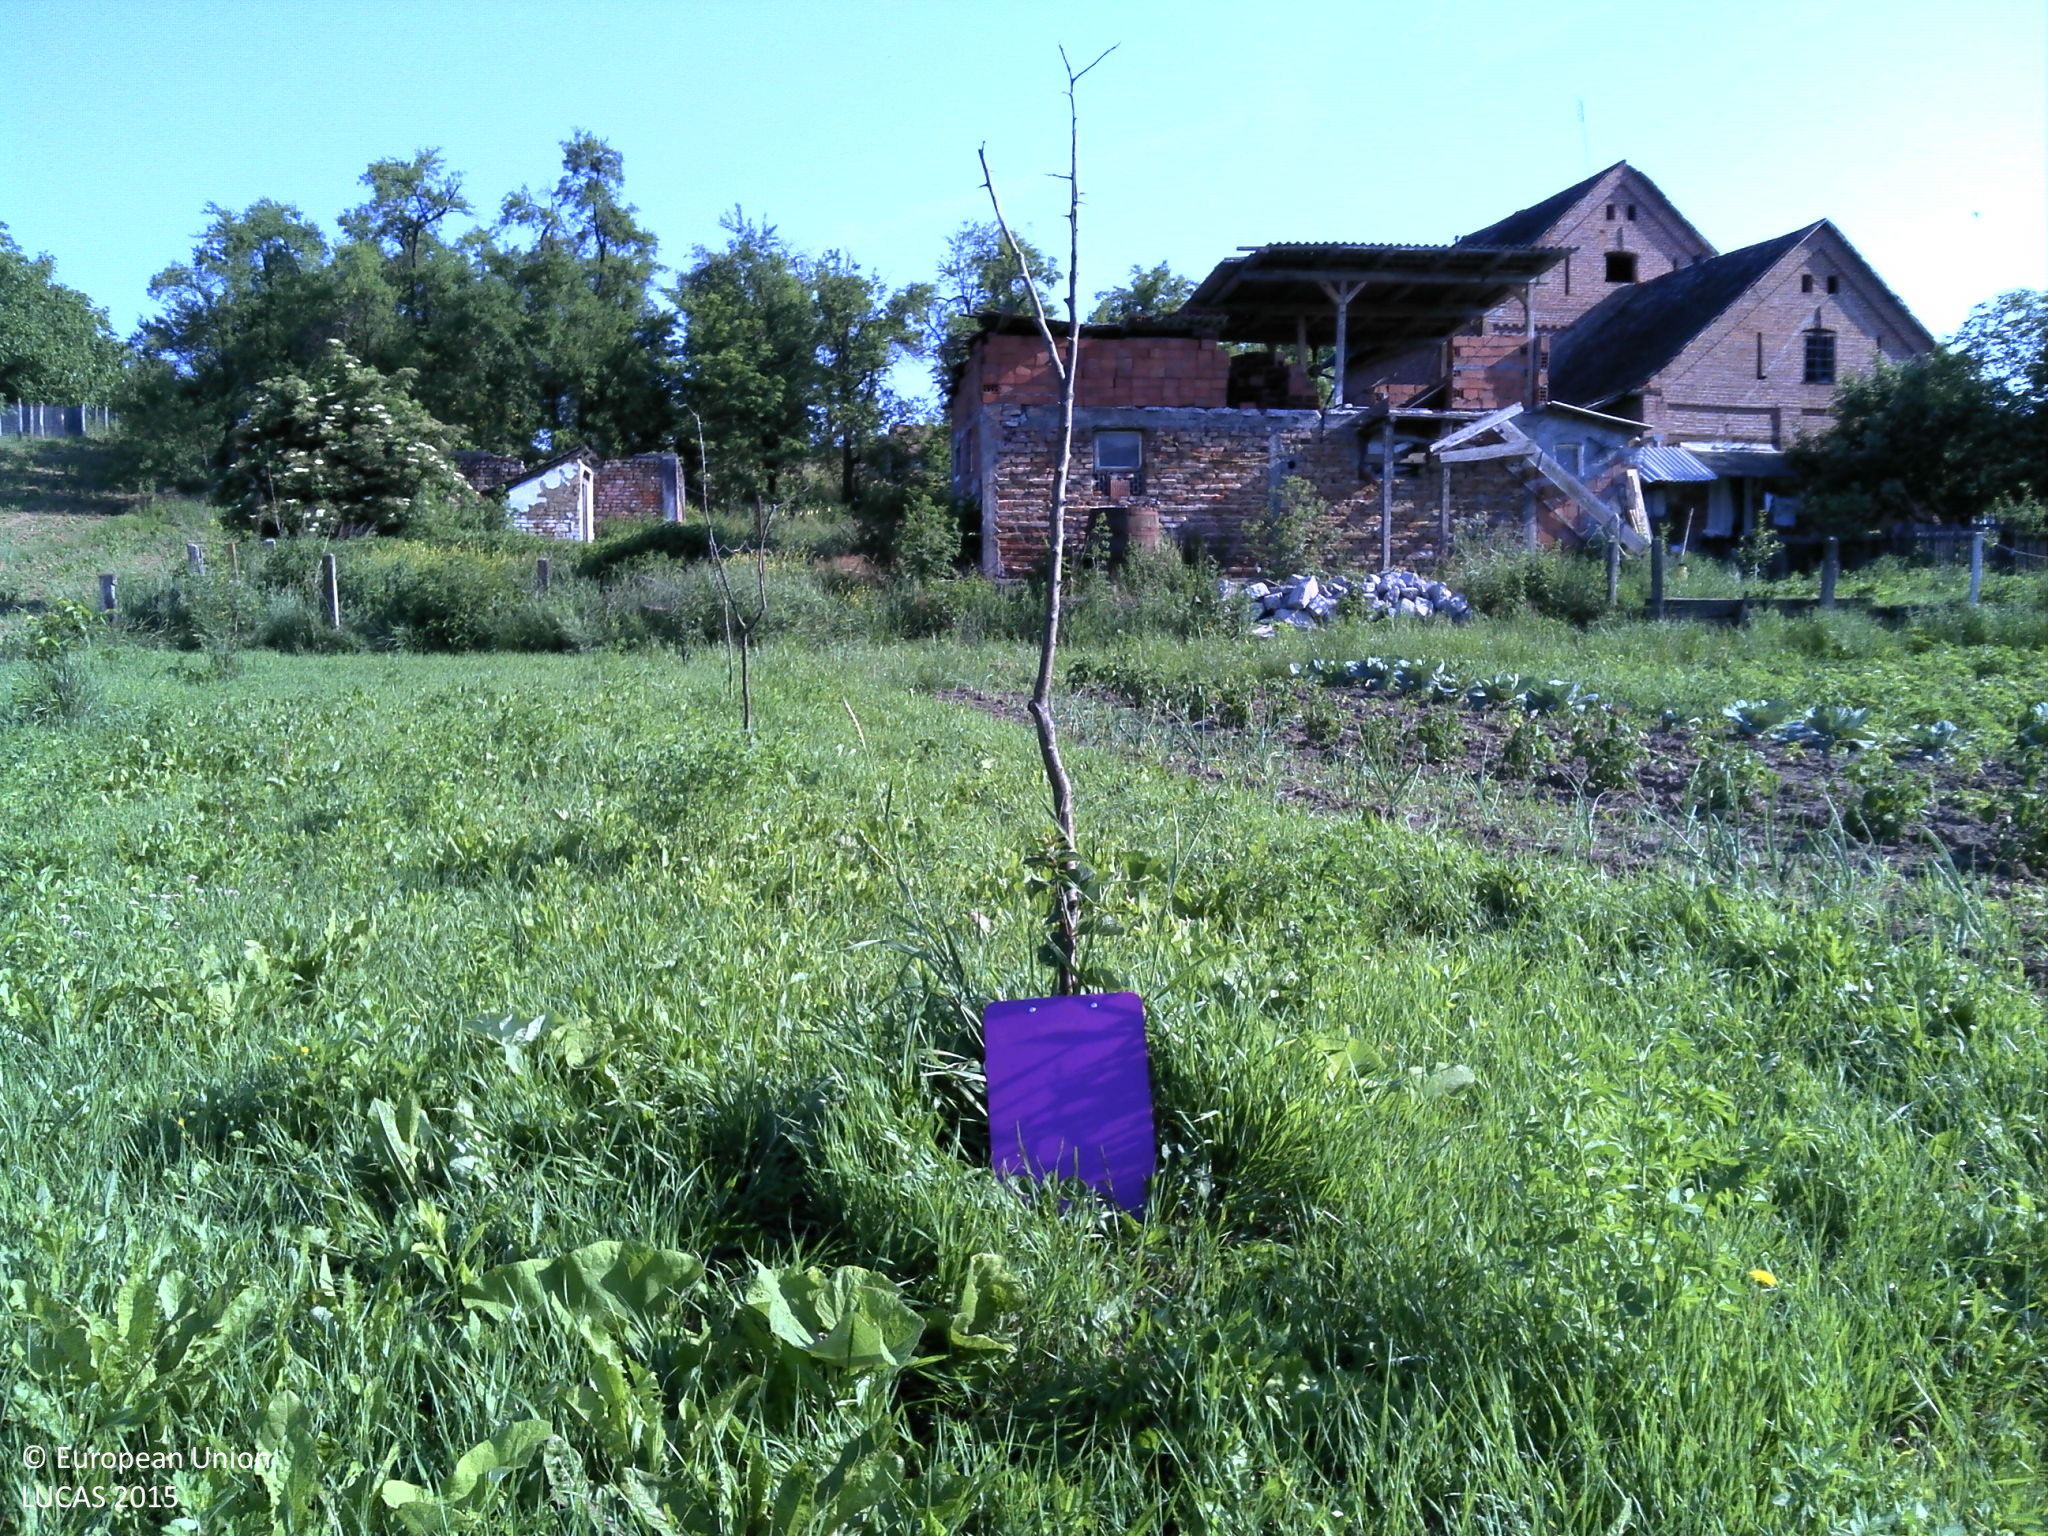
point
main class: Cropland
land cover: Other fruit trees and berries
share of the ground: < 10 %
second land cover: Grassland without tree/shrub cover
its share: > 75 %
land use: Kitchen garden
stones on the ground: < 10 %
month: June
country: HR
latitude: 45.3133
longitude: 18.1802
